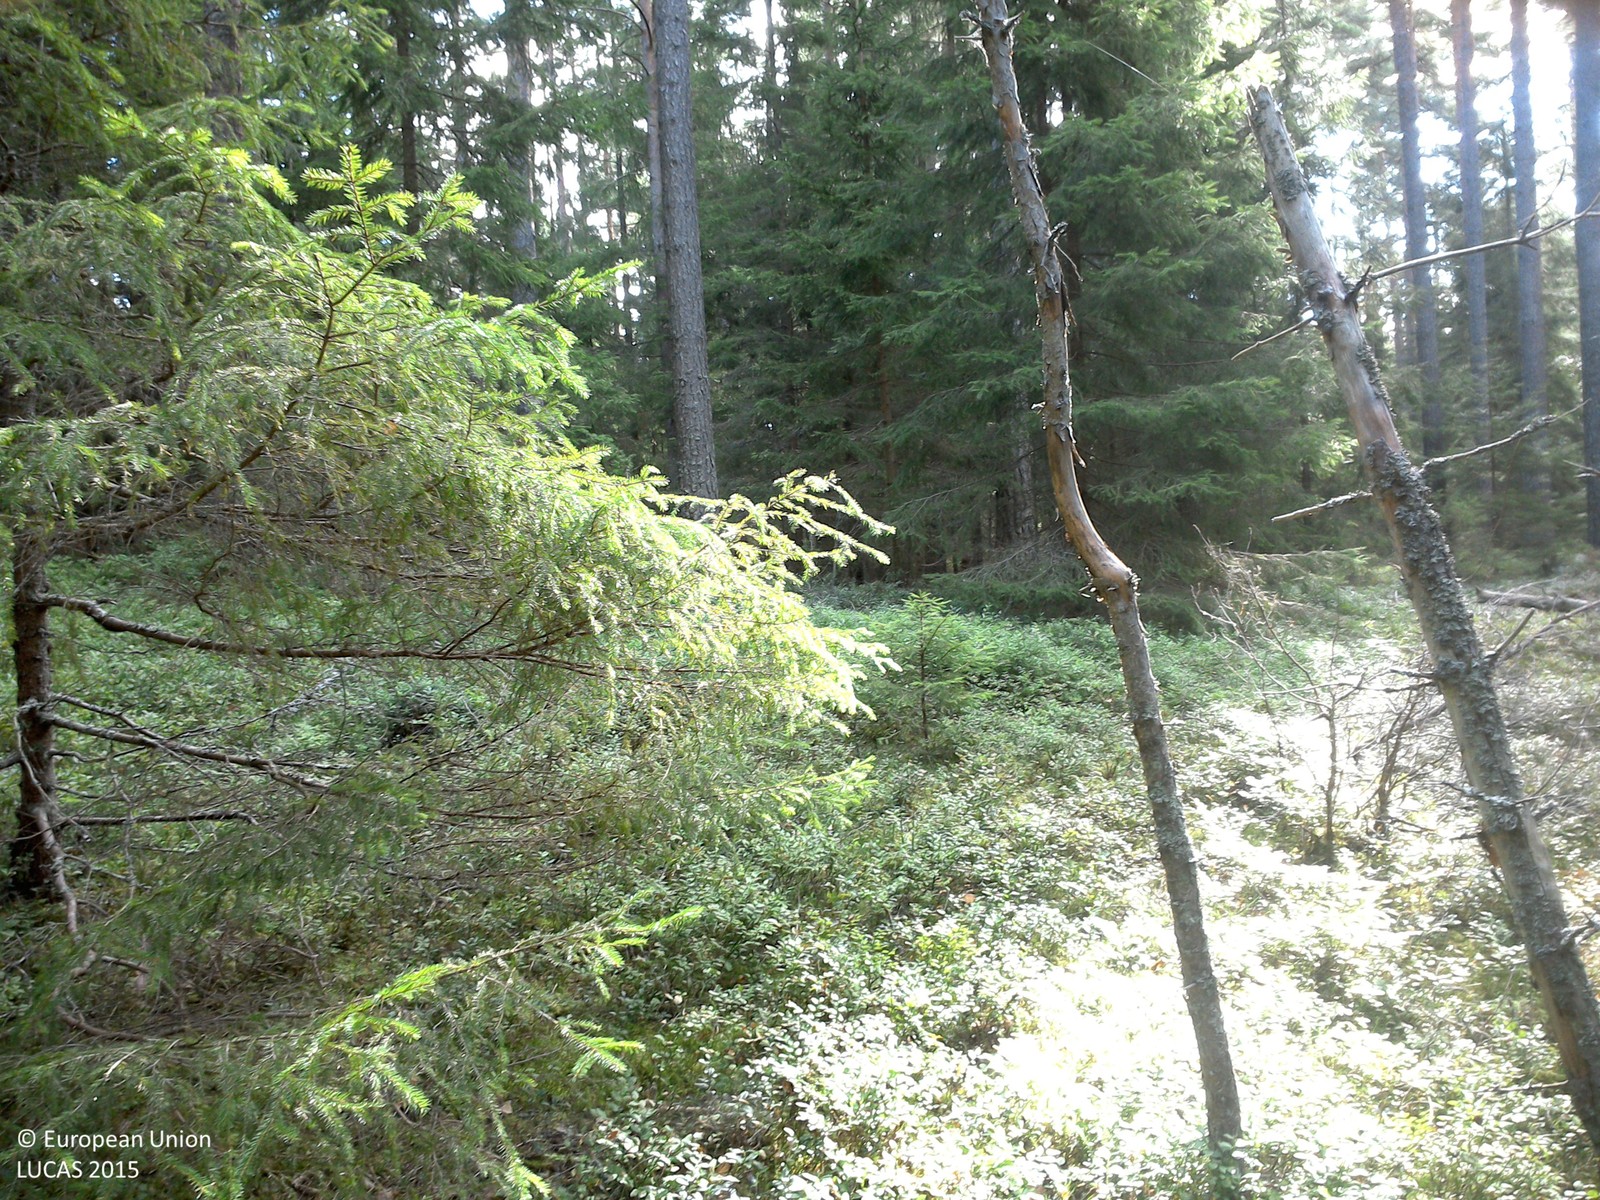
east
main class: Woodland
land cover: Spruce dominated coniferous woodland
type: boreal forest
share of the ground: 25 - 50 %
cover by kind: coniferous forest trees 50 %, herbaceous plants 30 %, lichens and mosses 20 %
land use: Forestry
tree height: > 5 m
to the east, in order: Spruce dominated coniferous woodland; Pine dominated coniferous woodland; Paved roads, cycling and walking lanes; Pine dominated coniferous woodland; Tracks; Spruce dominated coniferous woodland
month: August
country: SE
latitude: 57.9010
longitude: 15.2428
